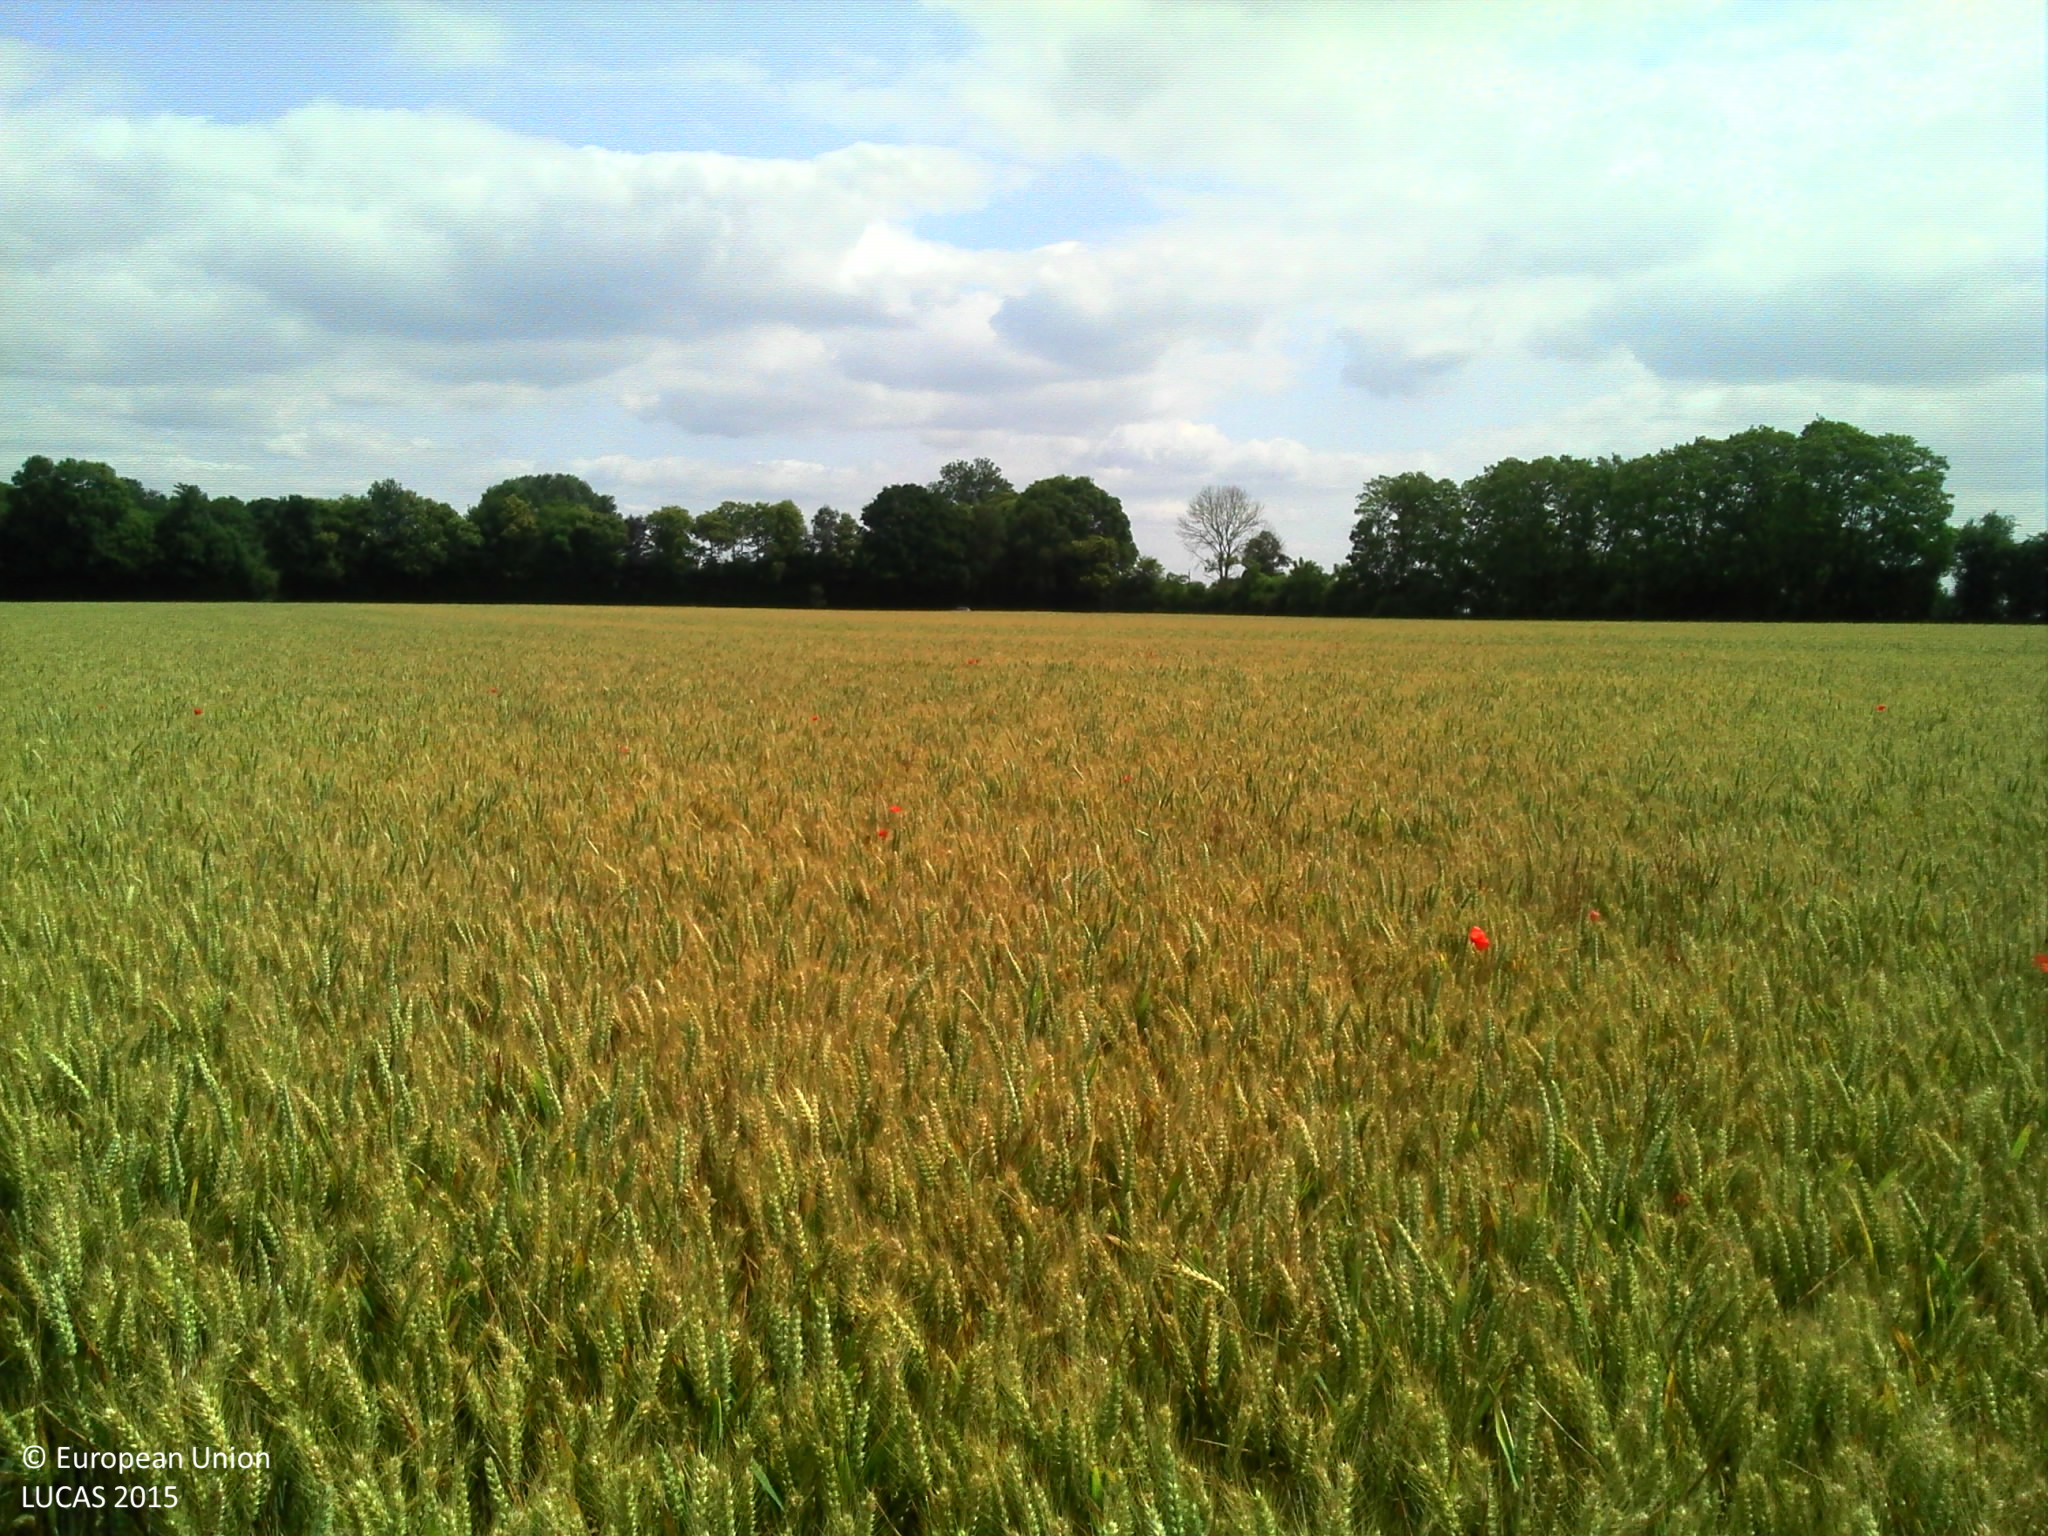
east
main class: Cropland
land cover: Common wheat
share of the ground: > 75 %
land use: Agriculture (excluding fallow land and kitchen gardens)
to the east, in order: Common wheat
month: July
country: FR
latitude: 49.1684
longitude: 0.4688
